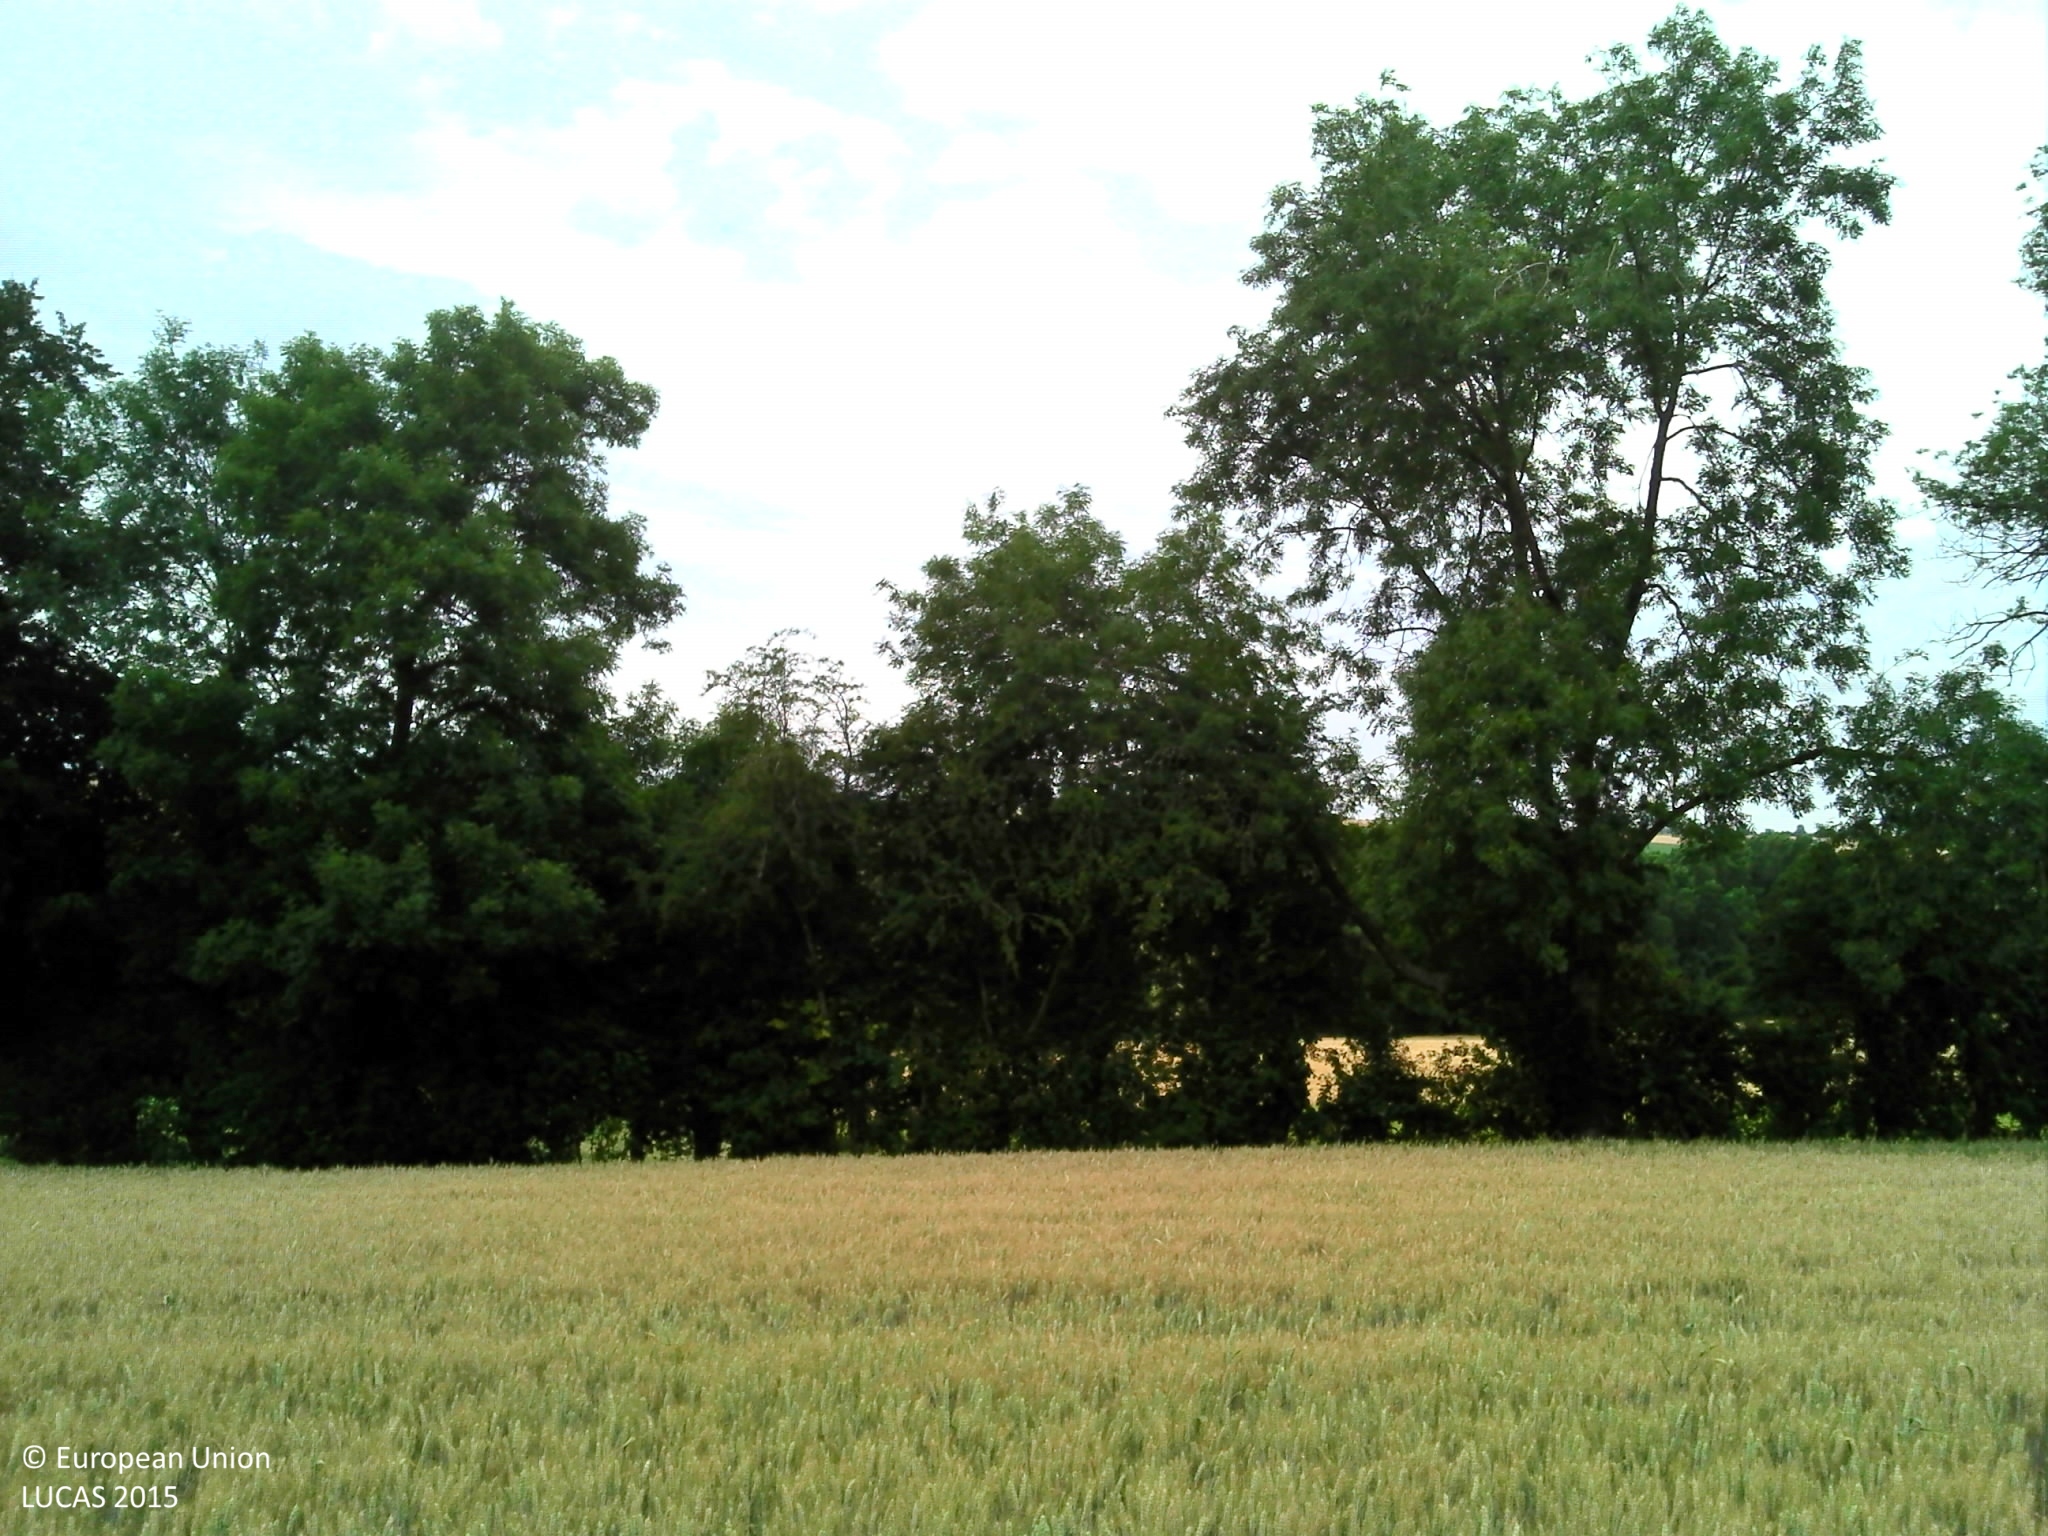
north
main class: Cropland
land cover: Common wheat
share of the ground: > 75 %
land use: Agriculture (excluding fallow land and kitchen gardens)
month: July
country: FR
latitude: 49.4906
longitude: 1.7971
